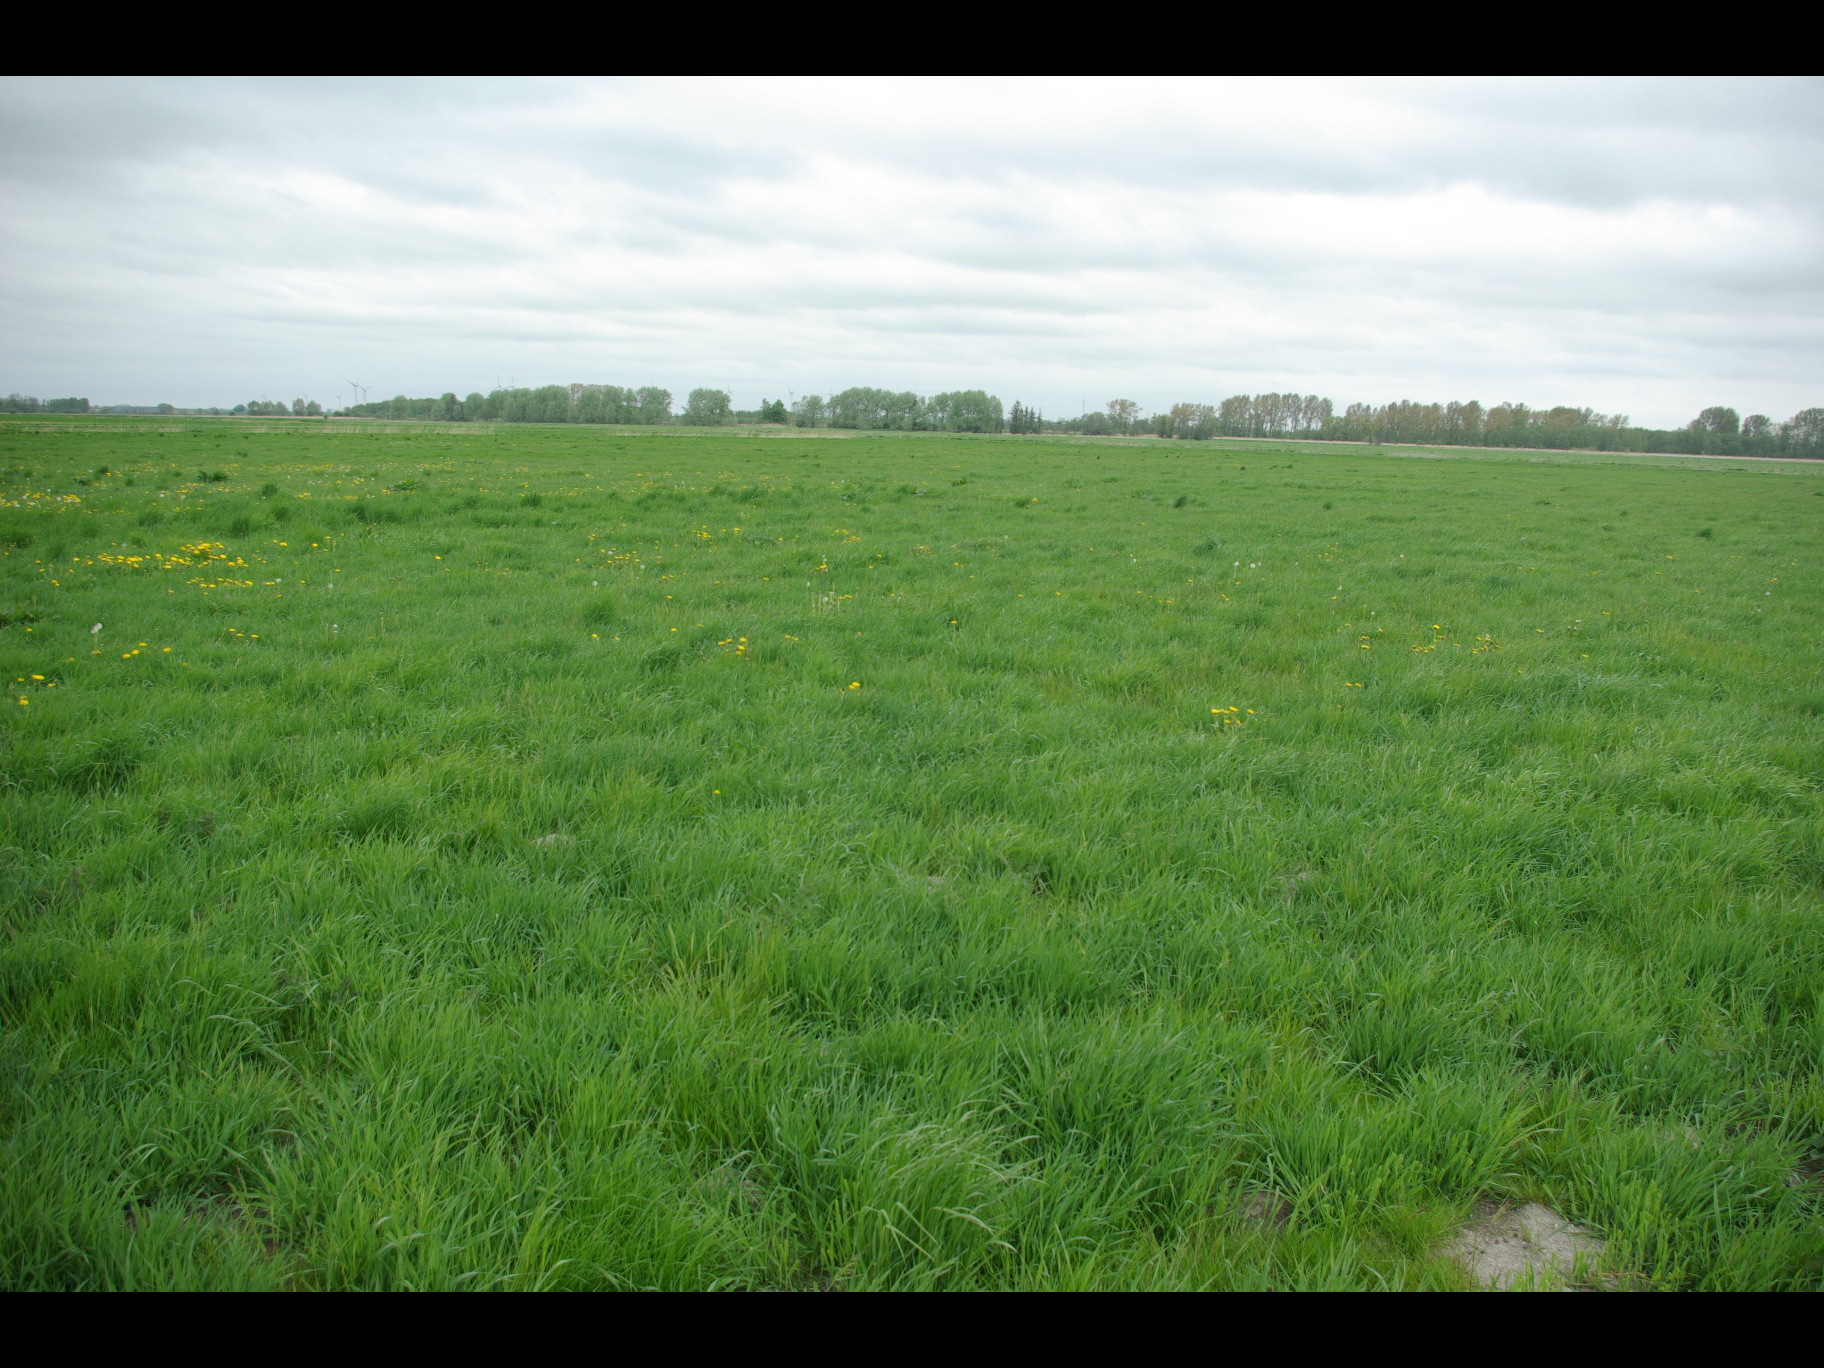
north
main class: Grassland
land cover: Grassland without tree/shrub cover
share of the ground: > 75 %
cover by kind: herbaceous plants 95 %, unconsolidated bare surface 5 %
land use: Agriculture (excluding fallow land and kitchen gardens)
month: May
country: DE
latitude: 54.2426
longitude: 10.9968
